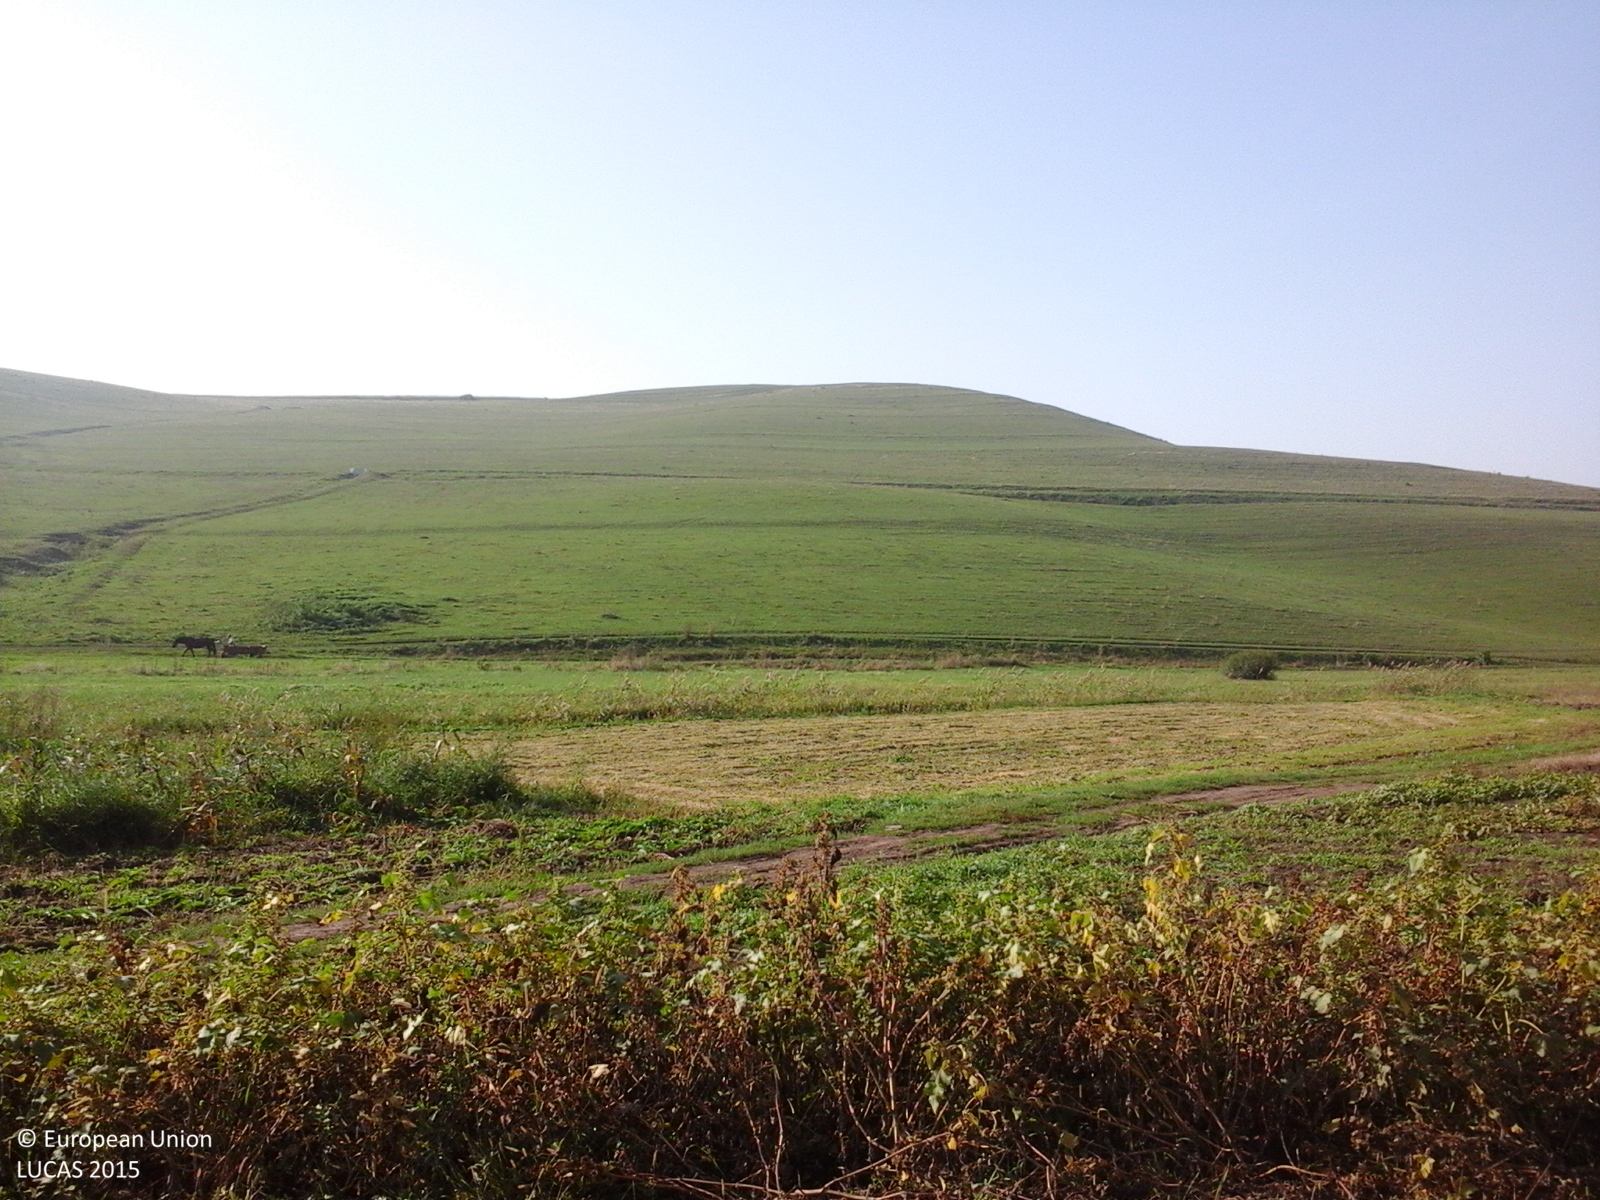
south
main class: Cropland
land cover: Potatoes
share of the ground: < 10 %
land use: Agriculture (excluding fallow land and kitchen gardens)
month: September
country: RO
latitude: 46.6111
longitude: 24.0095
